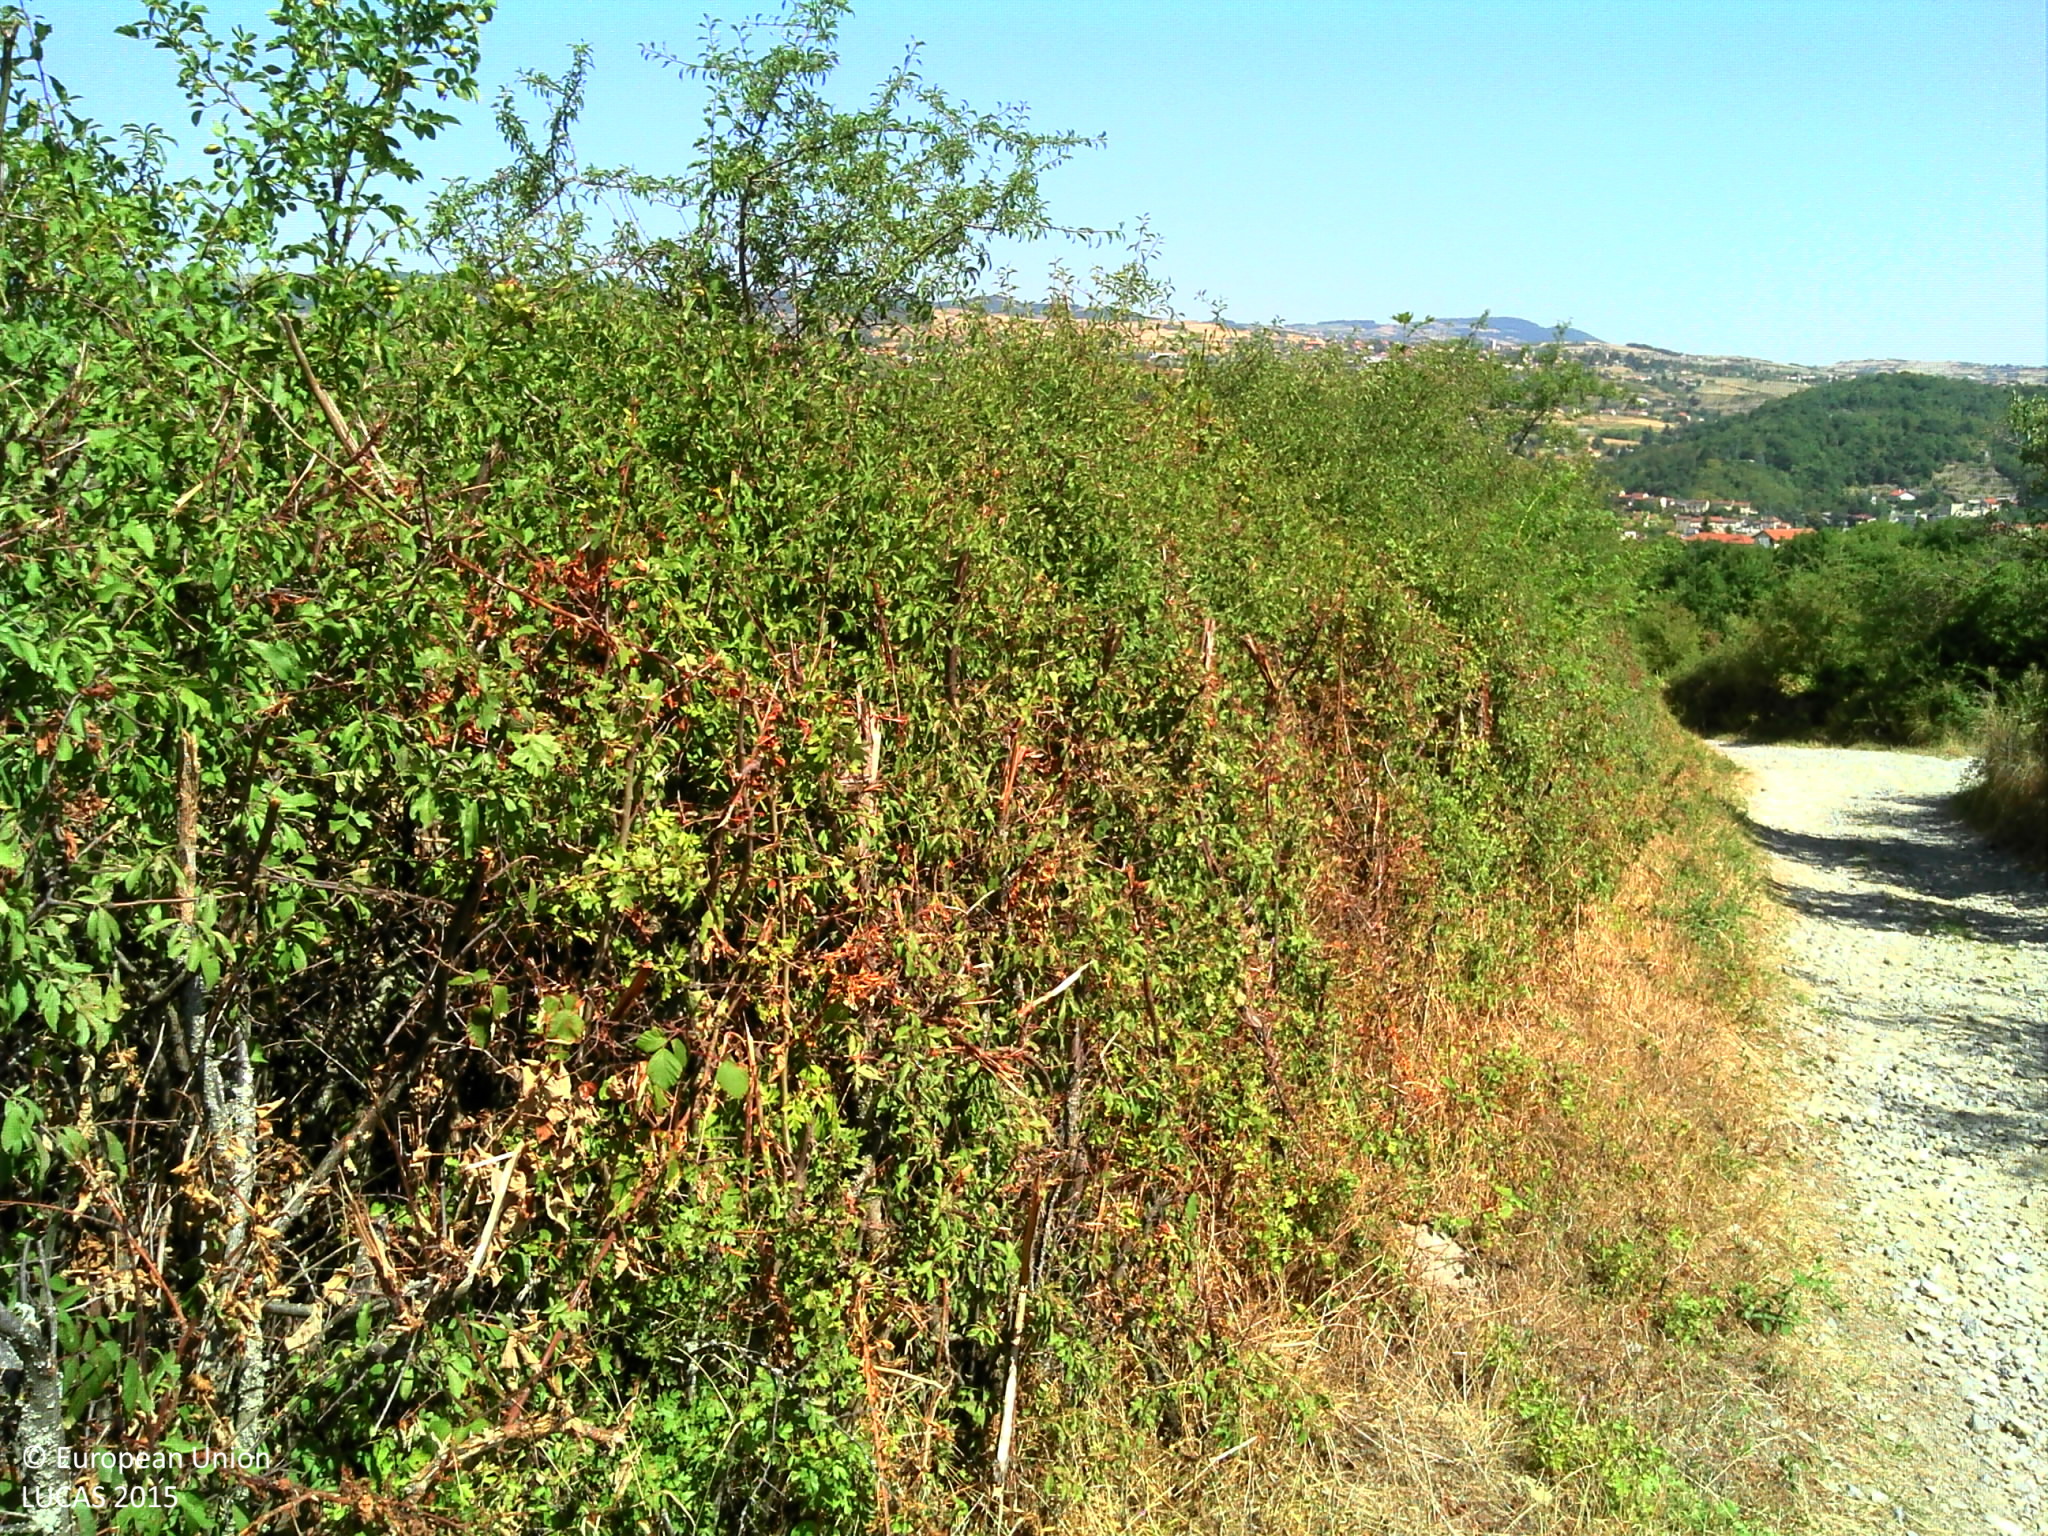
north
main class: Grassland
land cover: Grassland without tree/shrub cover
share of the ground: > 75 %
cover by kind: herbaceous plants 90 %, unconsolidated bare surface 10 %
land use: Agriculture (excluding fallow land and kitchen gardens)
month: August
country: FR
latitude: 45.5102
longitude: 4.5895
